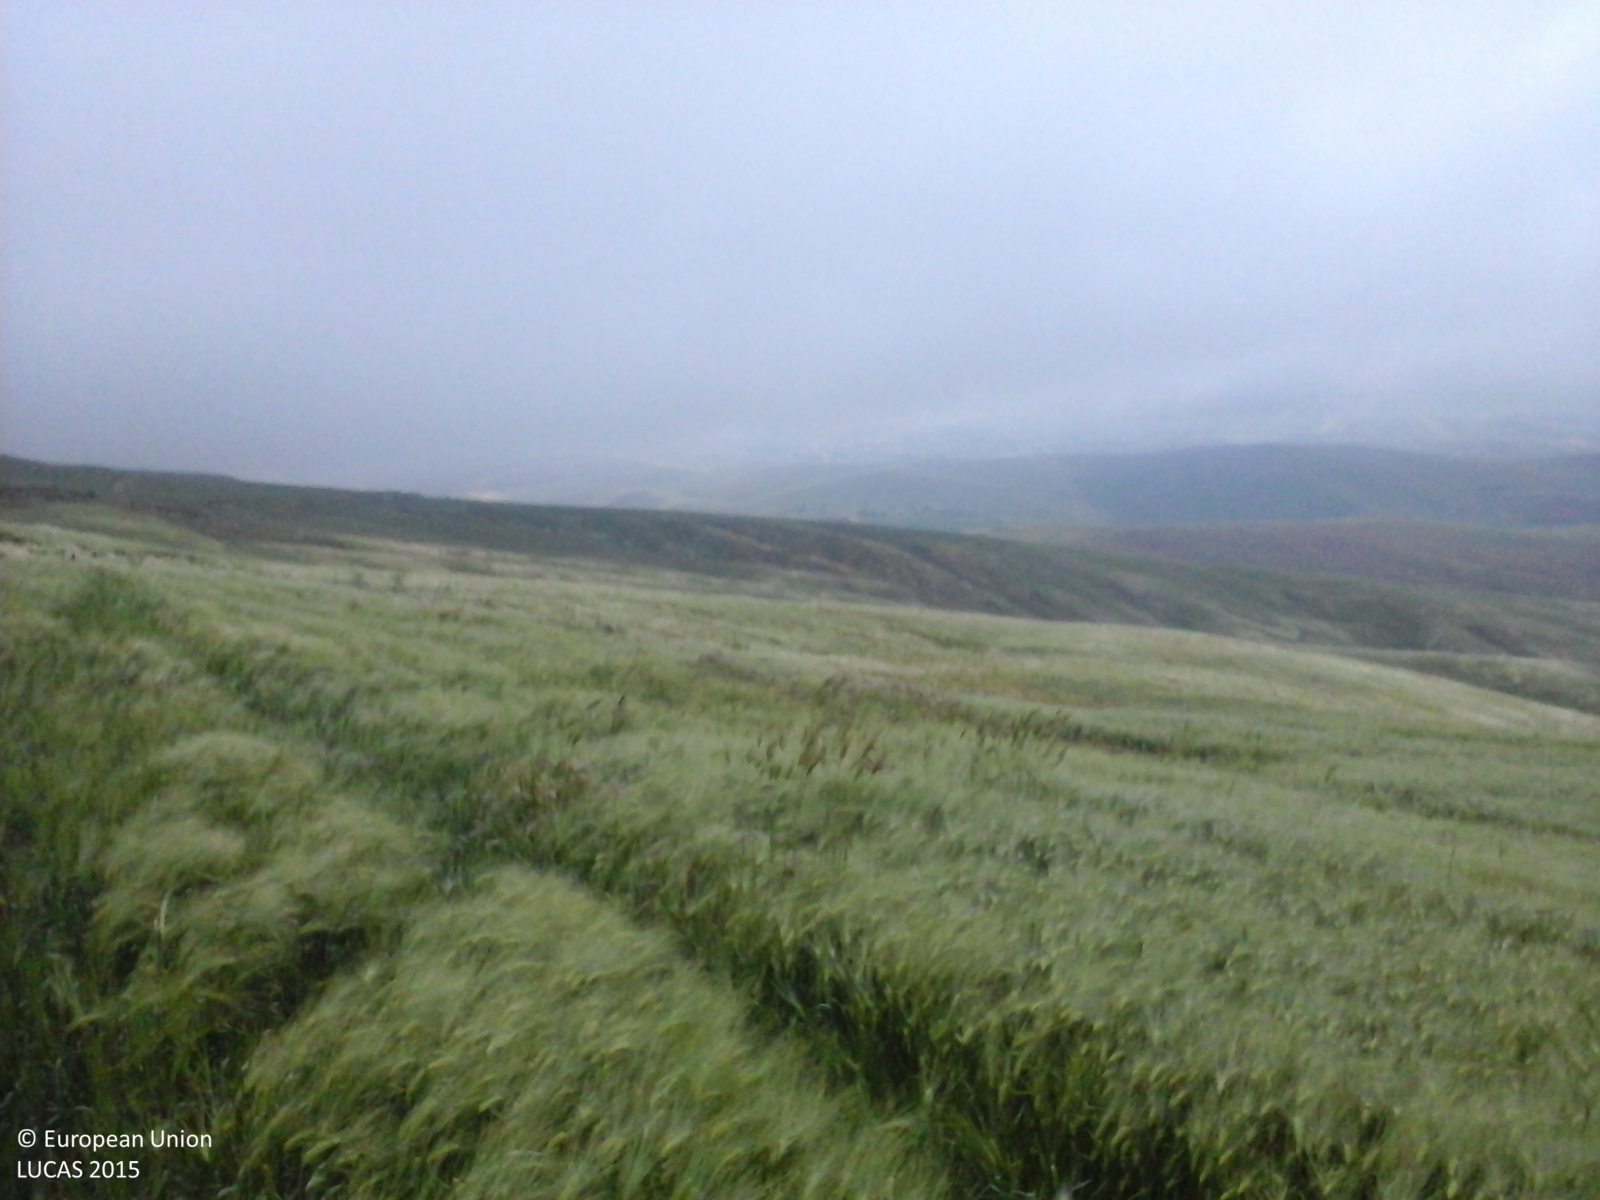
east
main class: Cropland
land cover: Barley
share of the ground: > 75 %
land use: Agriculture (excluding fallow land and kitchen gardens)
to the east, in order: Barley
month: May
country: IT
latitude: 37.7542
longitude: 14.0004
